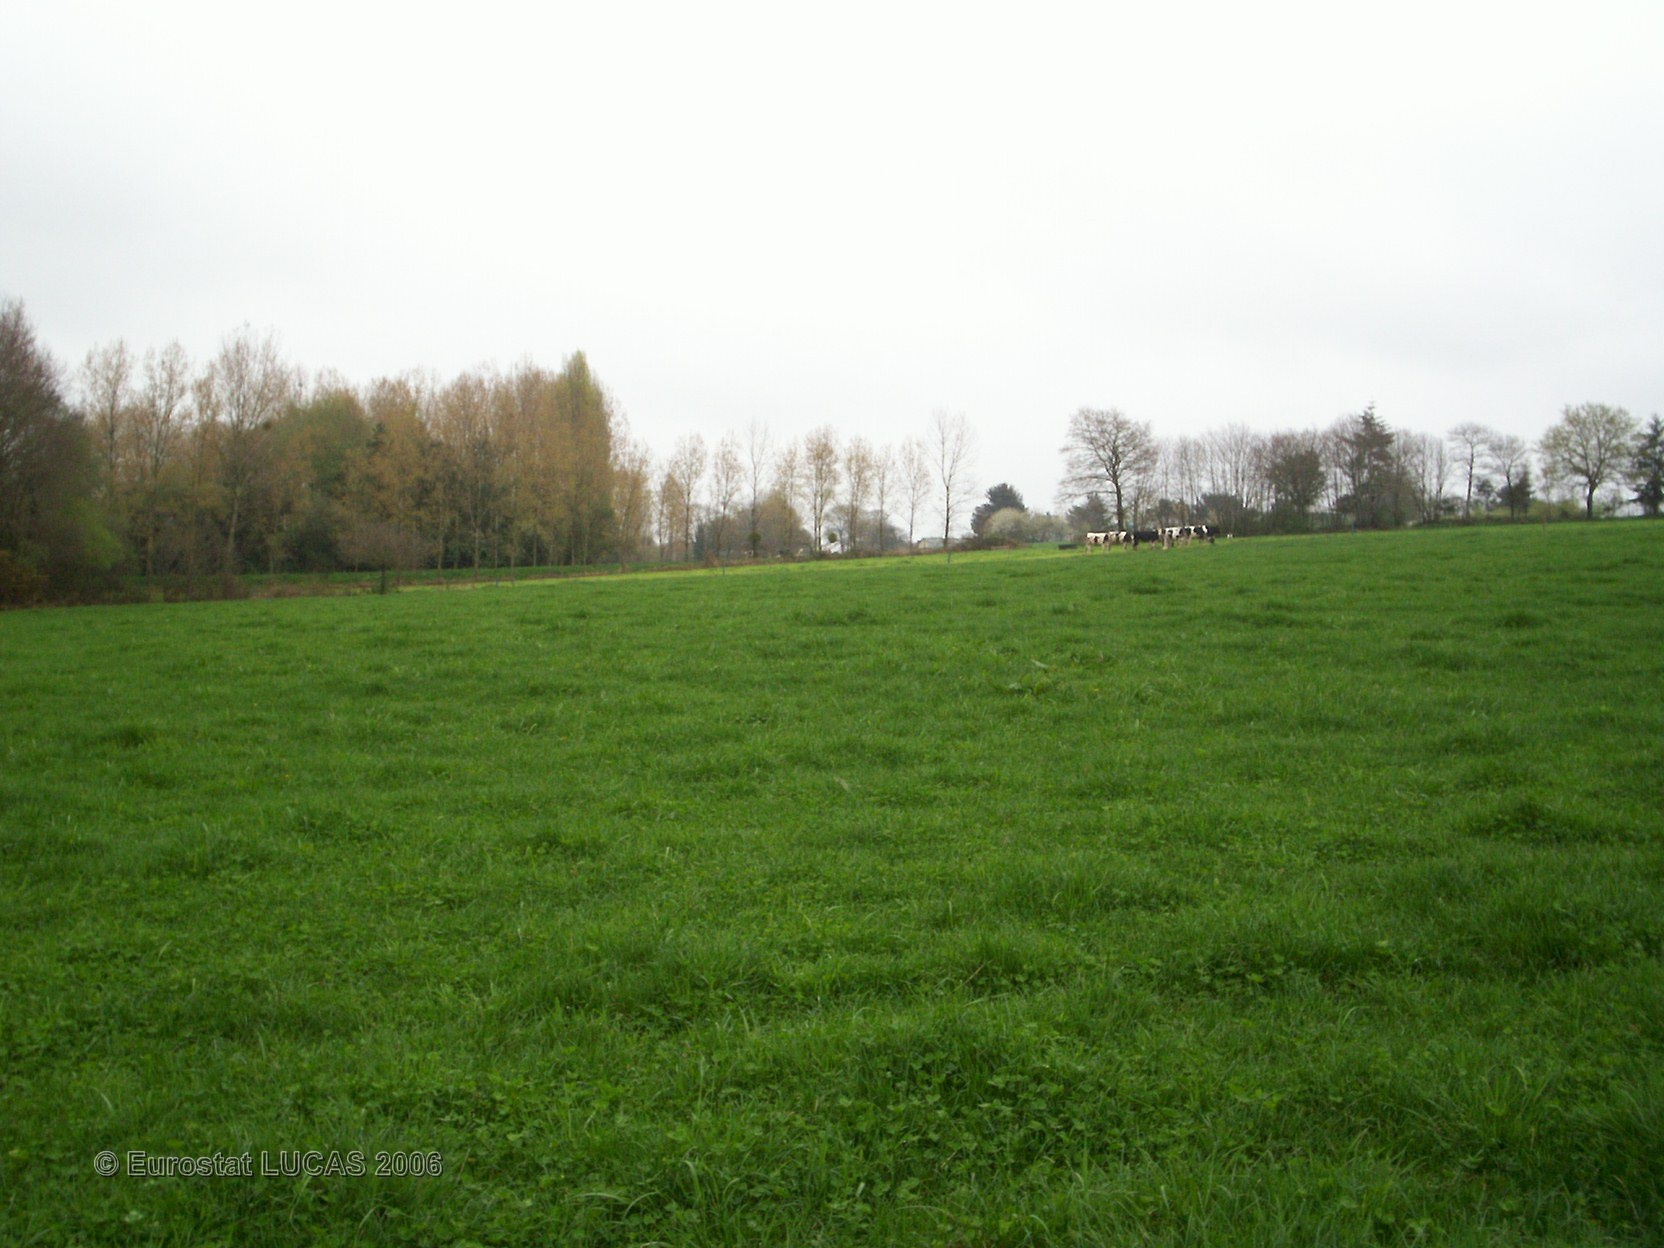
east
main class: Grassland
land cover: Grassland without tree/shrub cover
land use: Agriculture (excluding fallow land and kitchen gardens)
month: April
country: FR
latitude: 48.0662
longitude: -2.7182
